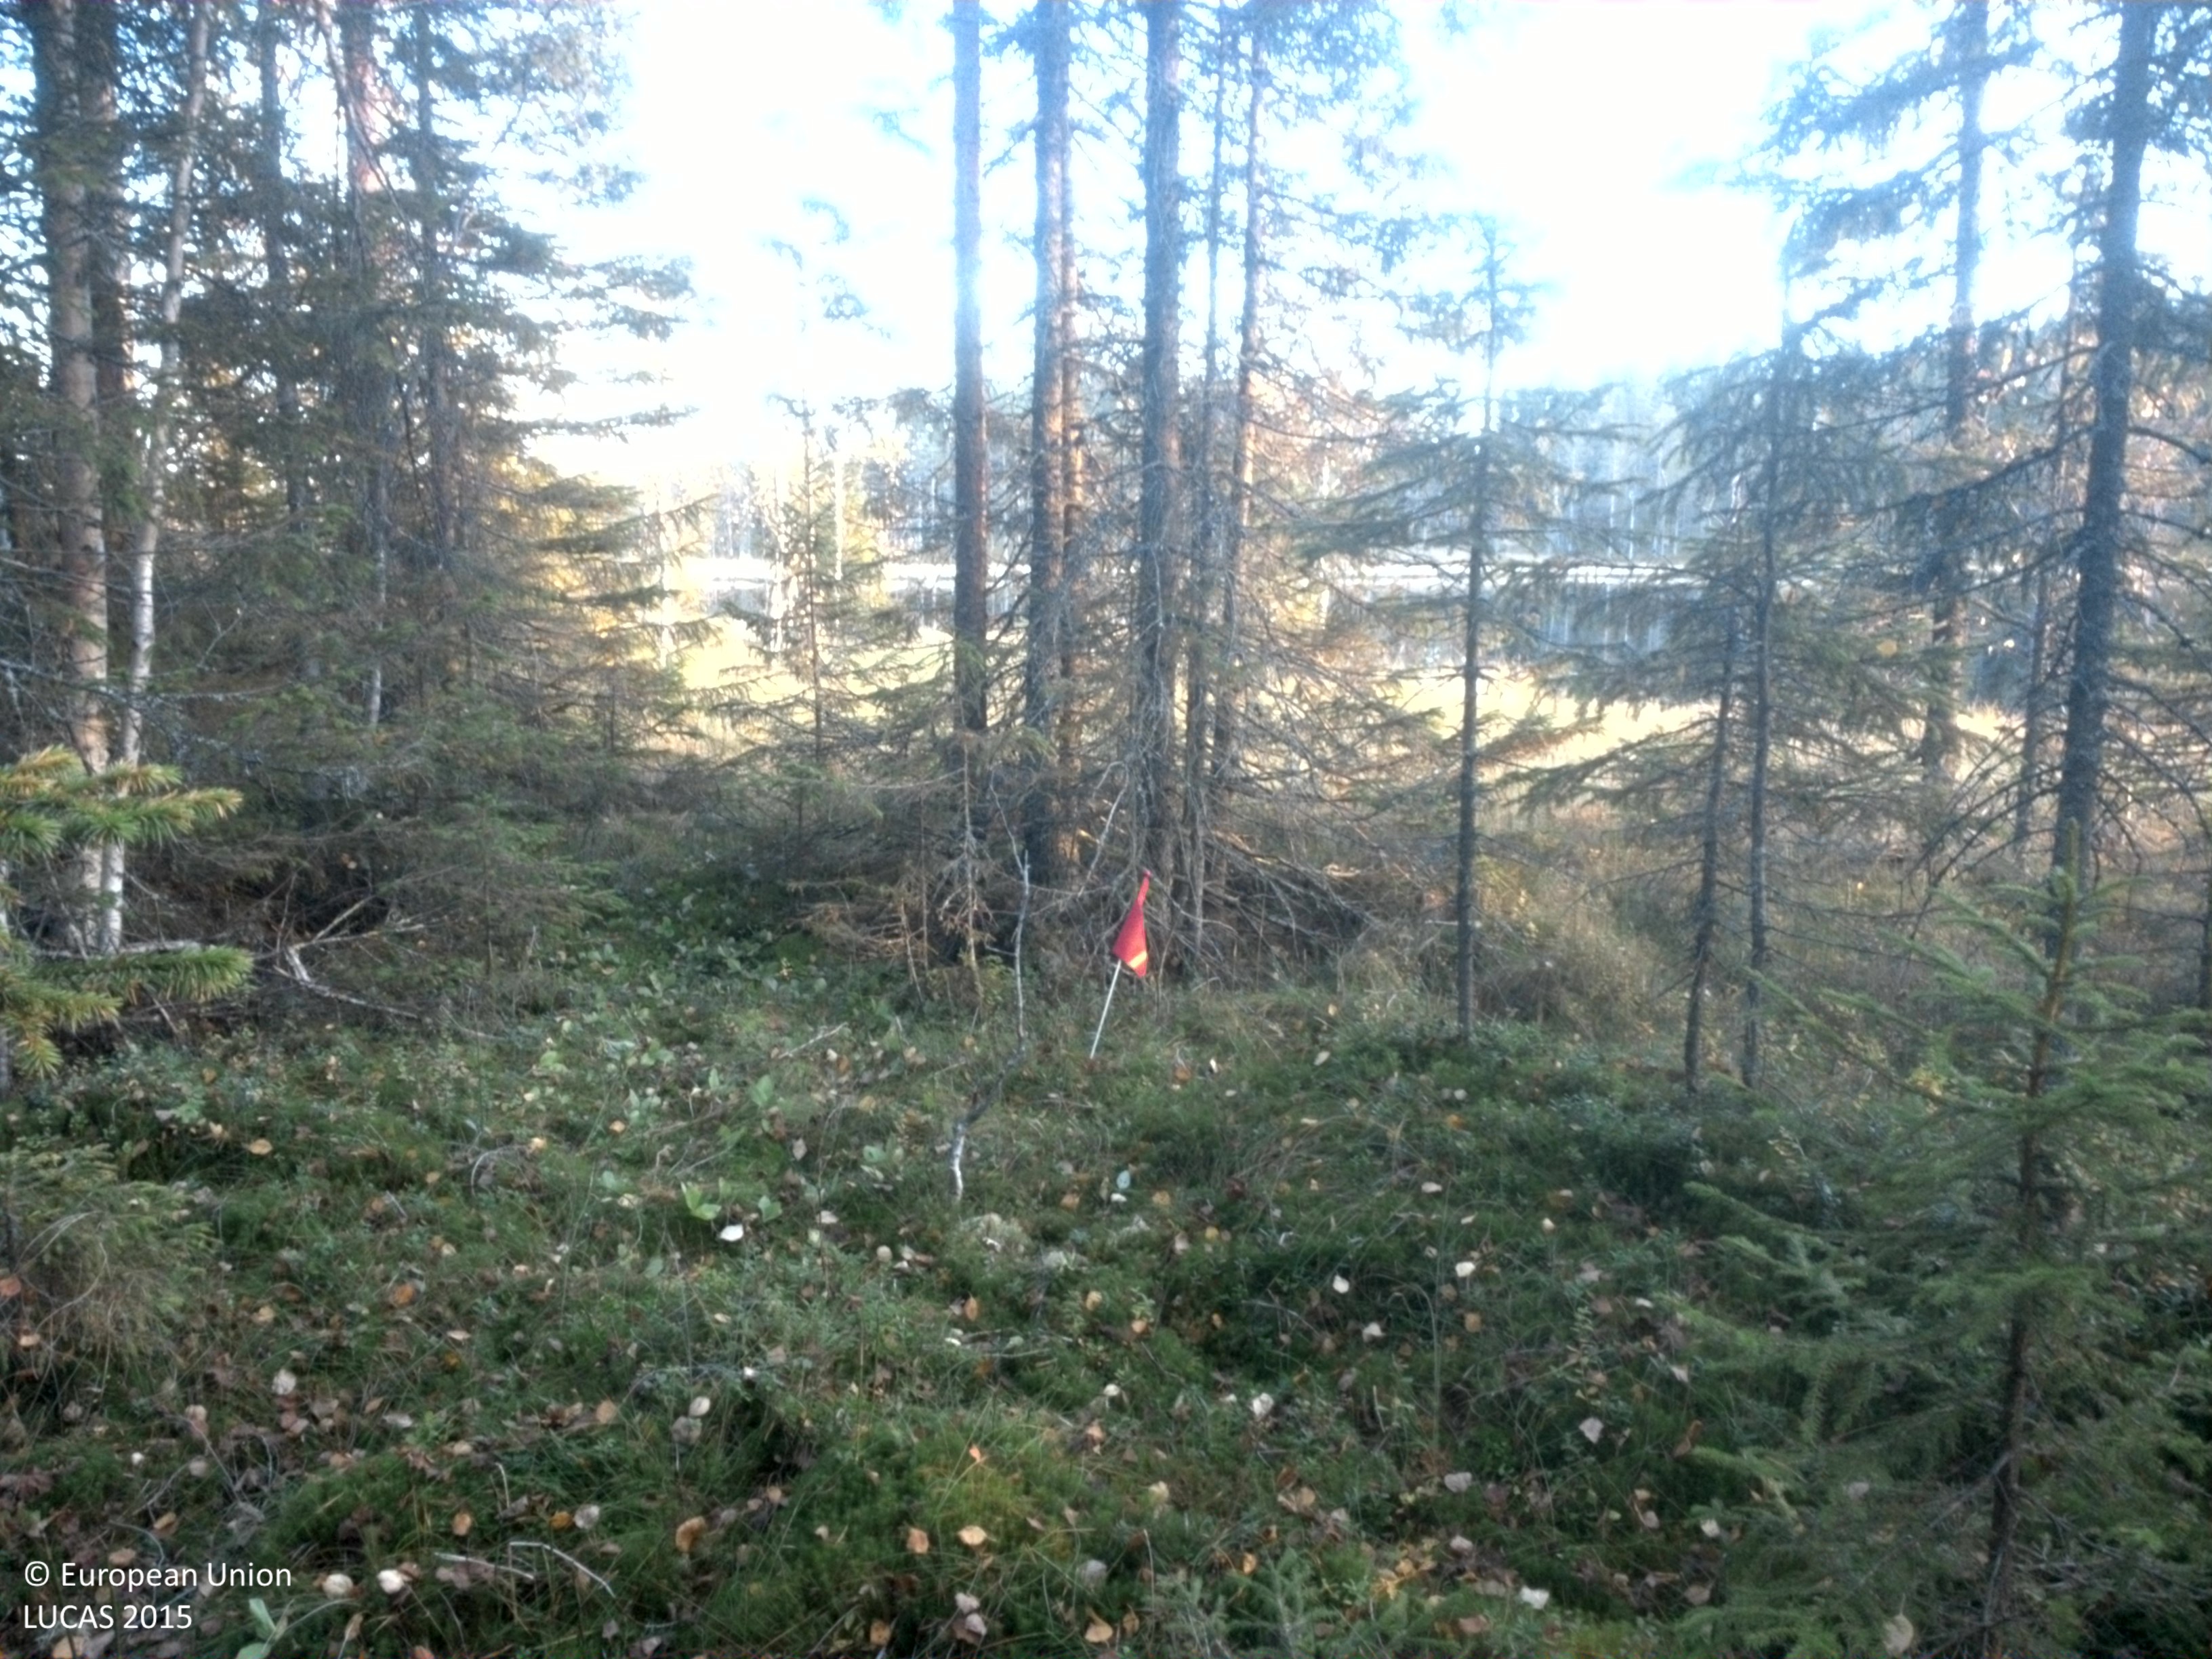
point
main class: Woodland
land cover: Other mixed woodland
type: boreal forest
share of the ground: 50 - 75 %
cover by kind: coniferous forest trees 45 %, broadleaved forest trees 20 %, shrubs 20 %, lichens and mosses 10 %, herbaceous plants 5 %
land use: Forestry
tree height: > 5 m
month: September
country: SE
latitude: 64.1681
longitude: 20.0772
